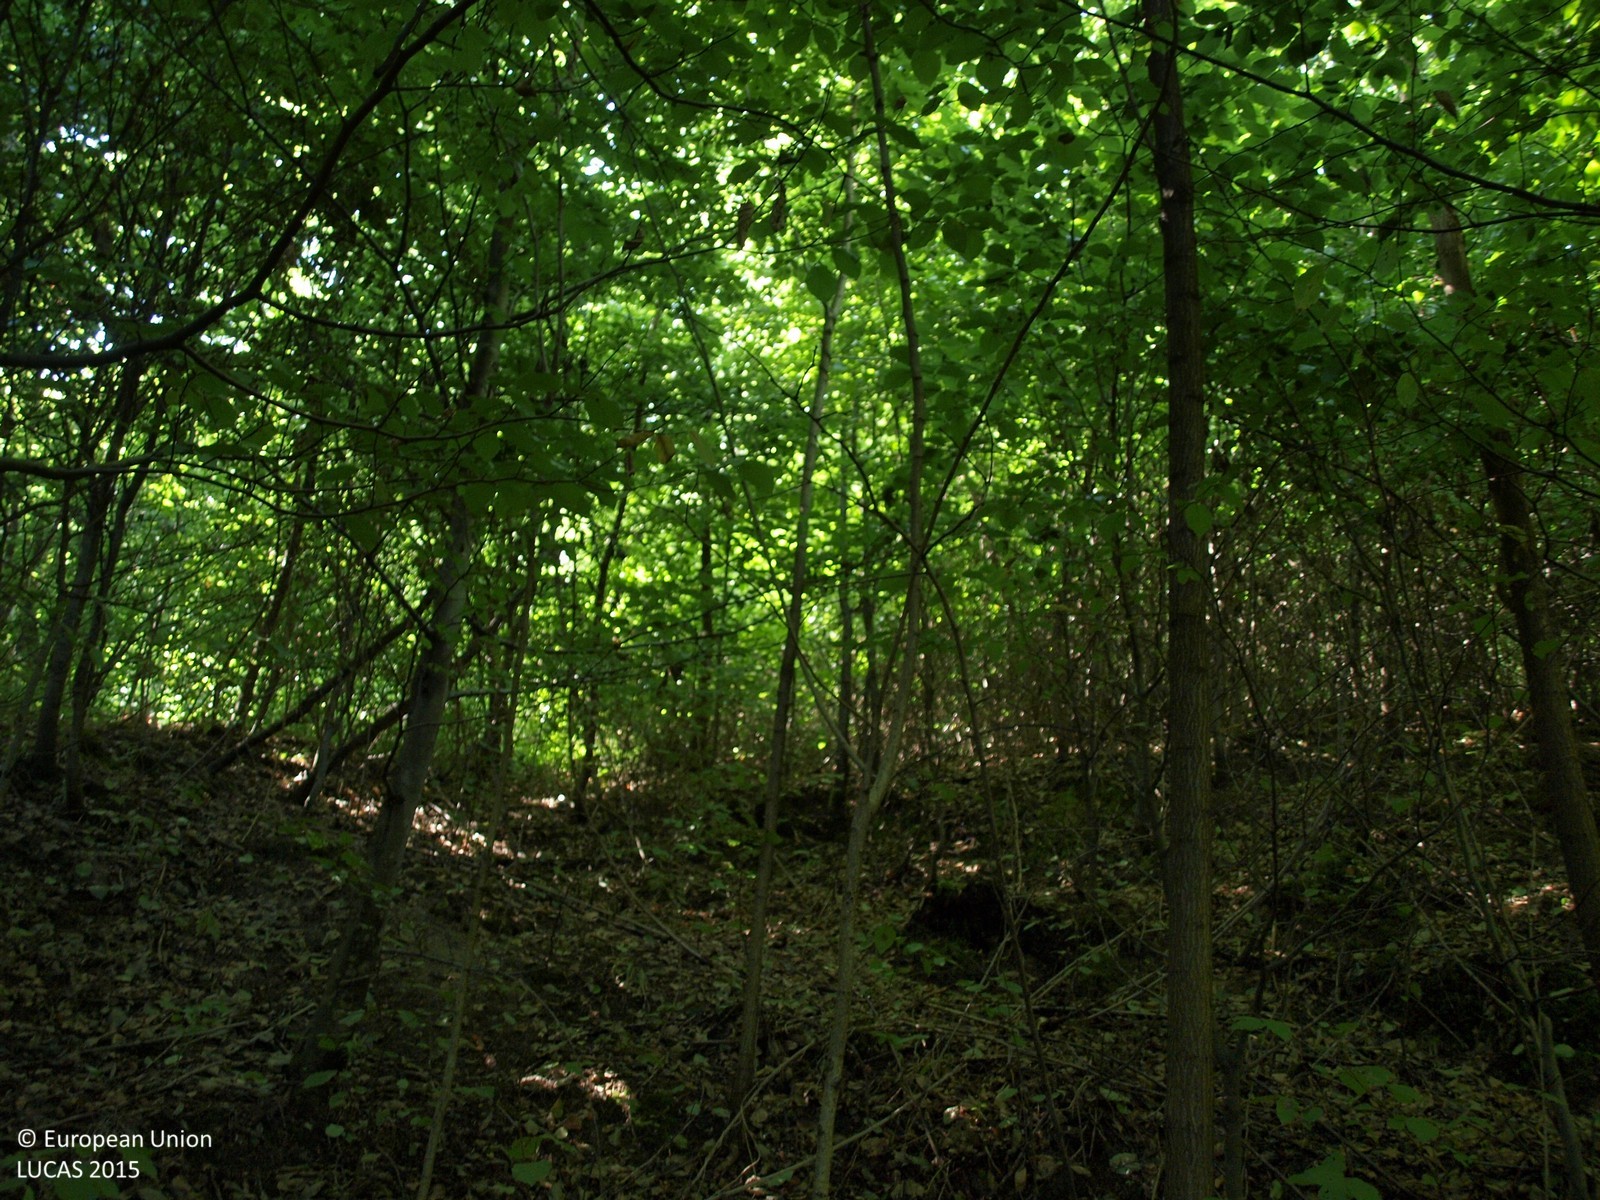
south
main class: Woodland
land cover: Broadleaved woodland
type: beech forest
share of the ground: > 75 %
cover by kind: broadleaved forest trees 100 %
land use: Forestry
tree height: > 5 m
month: August
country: HR
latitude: 46.0005
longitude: 16.3393
